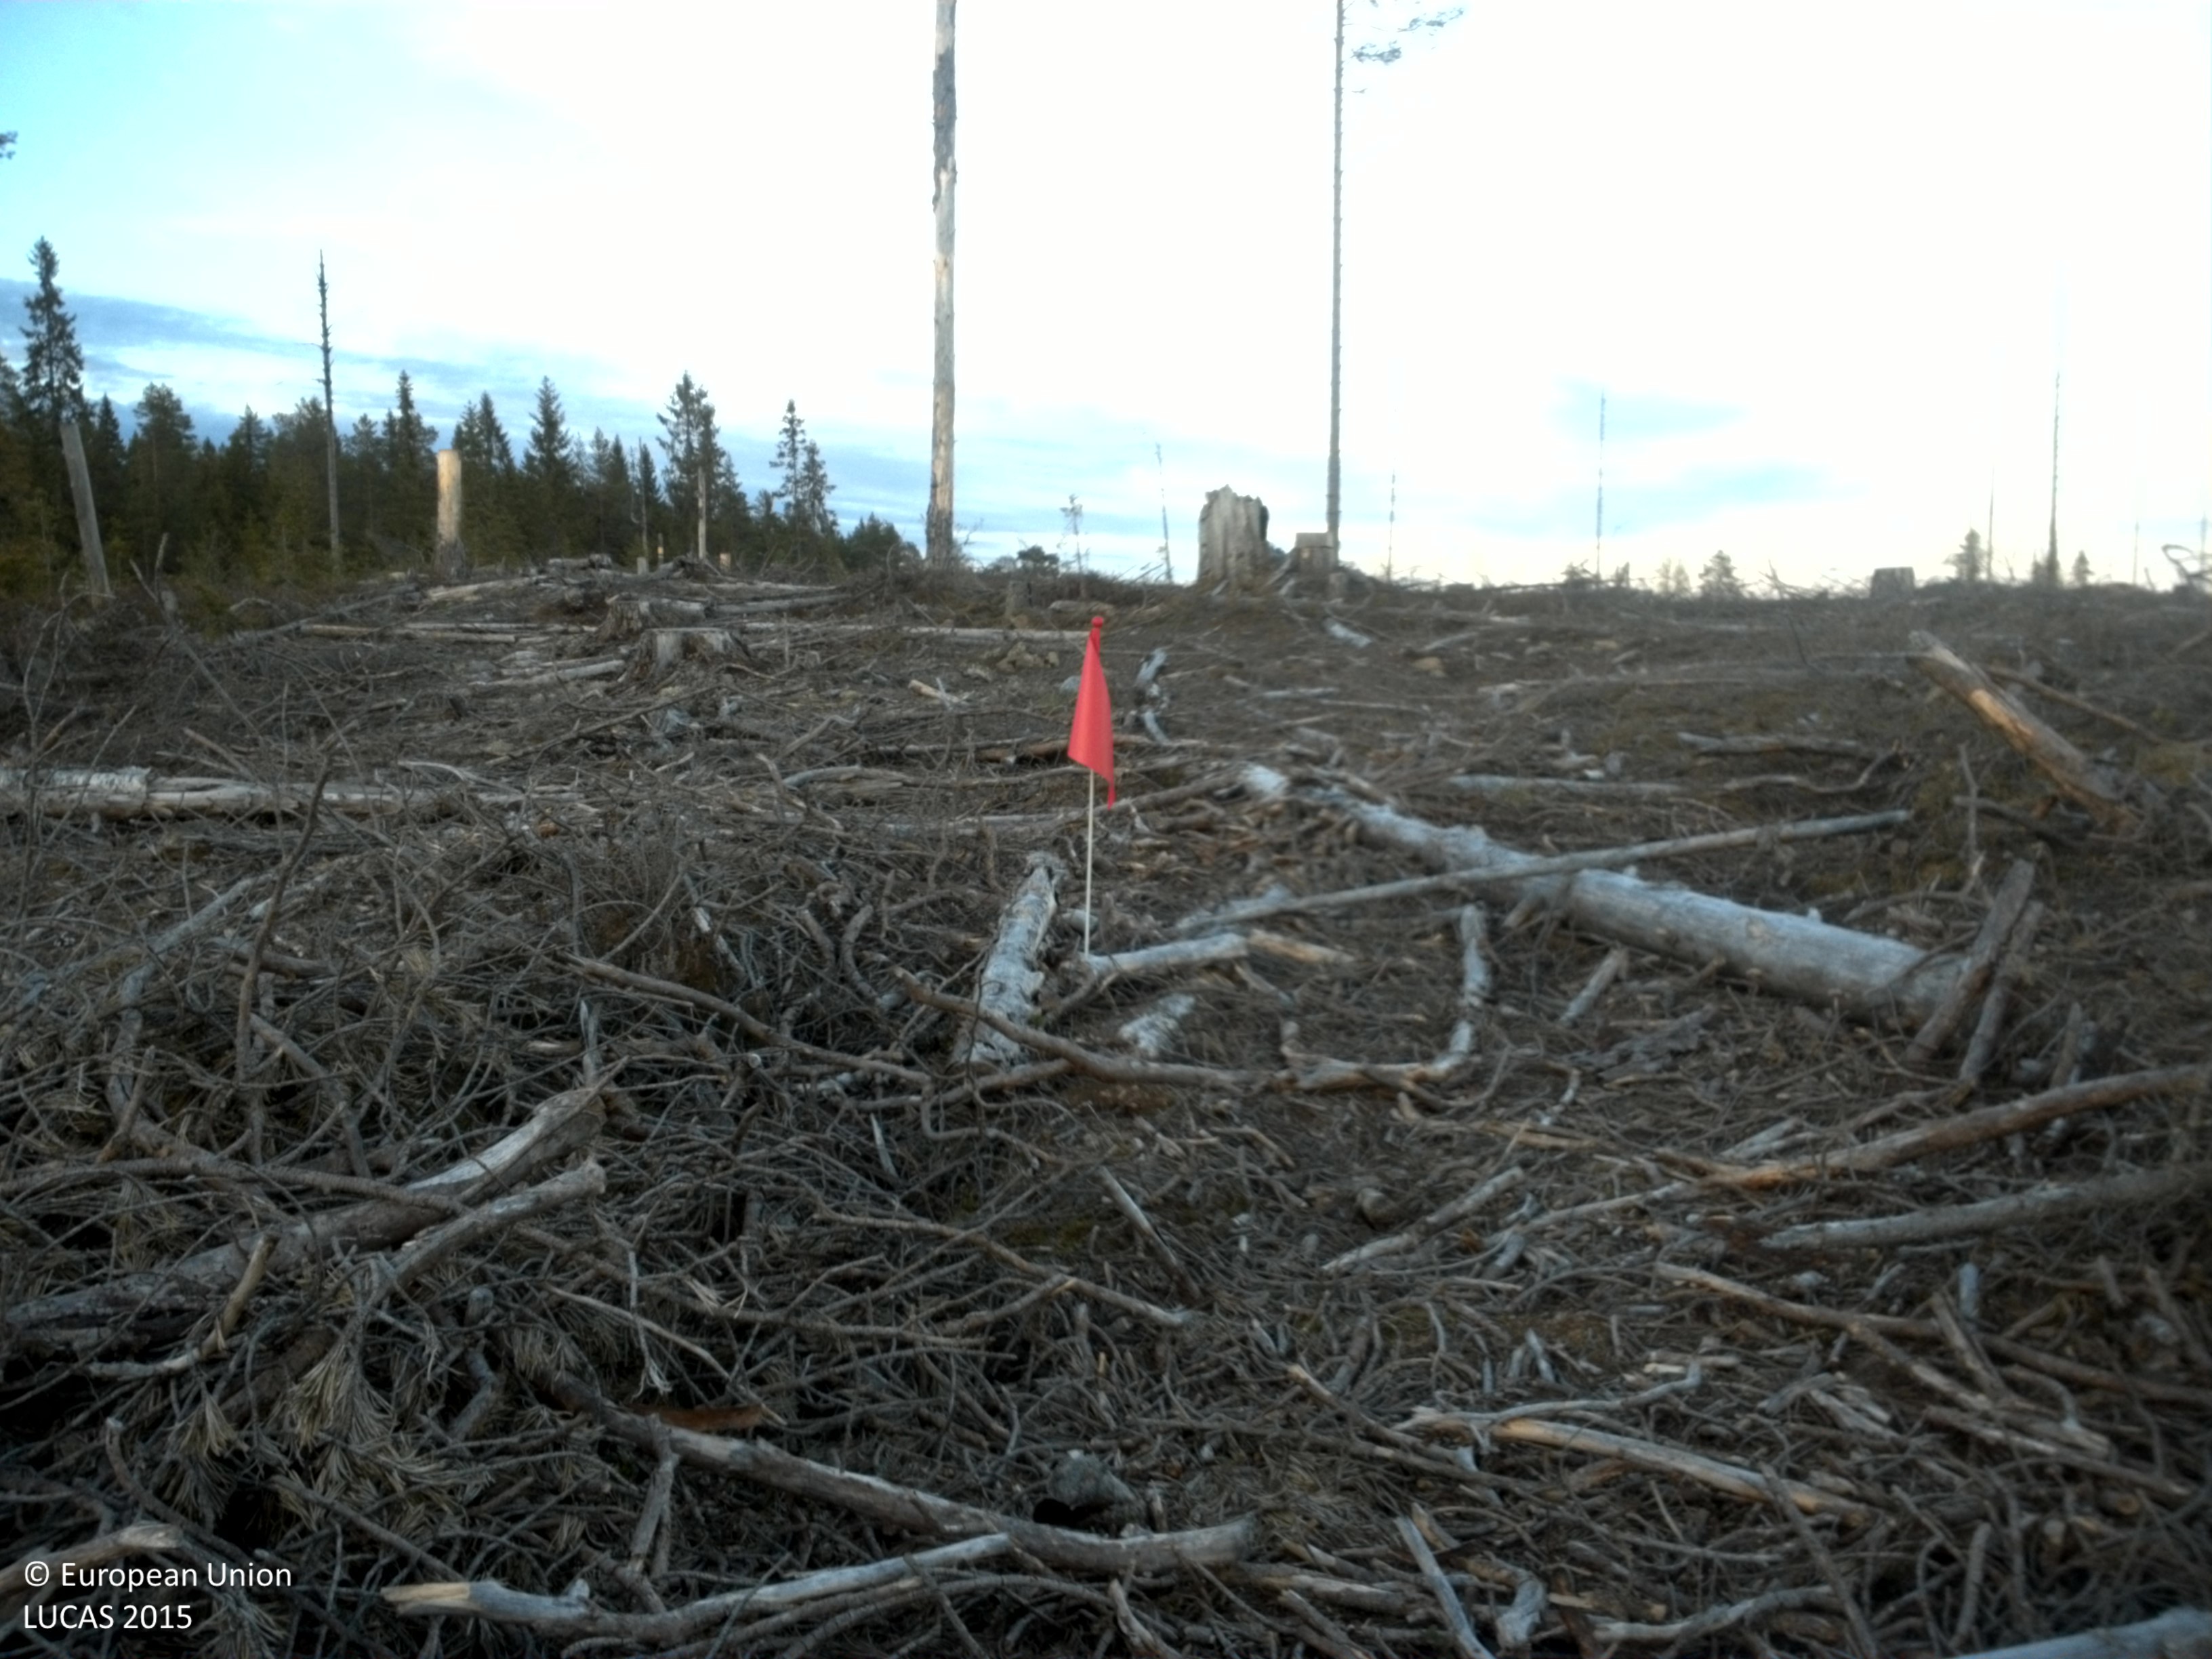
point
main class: Shrubland
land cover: Shrubland with sparse tree cover
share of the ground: 50 - 75 %
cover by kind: shrubs 55 %, lichens and mosses 10 %, consolidated bare surface 10 %, coniferous forest trees 5 %
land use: Forestry
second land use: Amenities, museums, leisure
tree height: > 5 m
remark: Clear cut
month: June
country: SE
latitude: 61.1321
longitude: 13.3494
